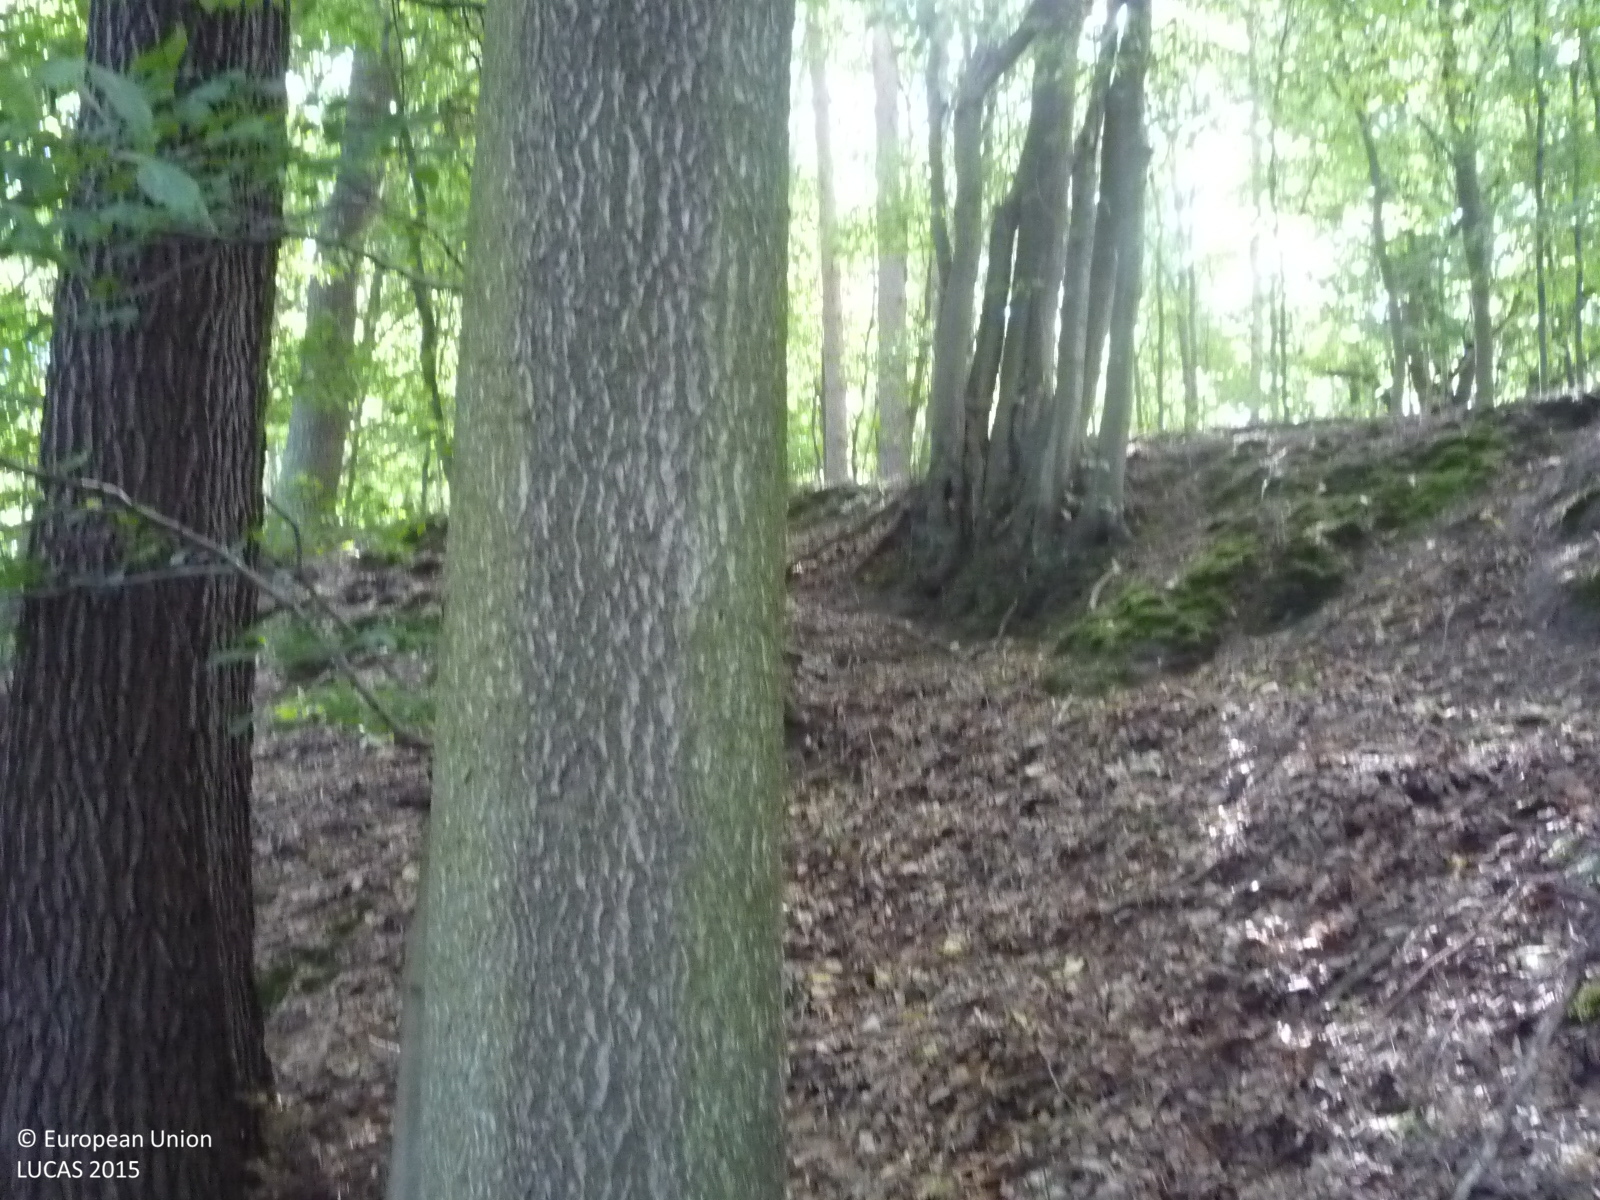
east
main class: Woodland
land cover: Pine dominated mixed woodland
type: hemiboreal forest and nemoral coniferous forest and mixed broadleaved-coniferous forest
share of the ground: > 75 %
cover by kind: broadleaved forest trees 60 %, coniferous forest trees 40 %
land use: Forestry
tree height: > 5 m
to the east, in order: Pine dominated mixed woodland; Broadleaved woodland
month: July
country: CZ
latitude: 50.5254
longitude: 14.5581
